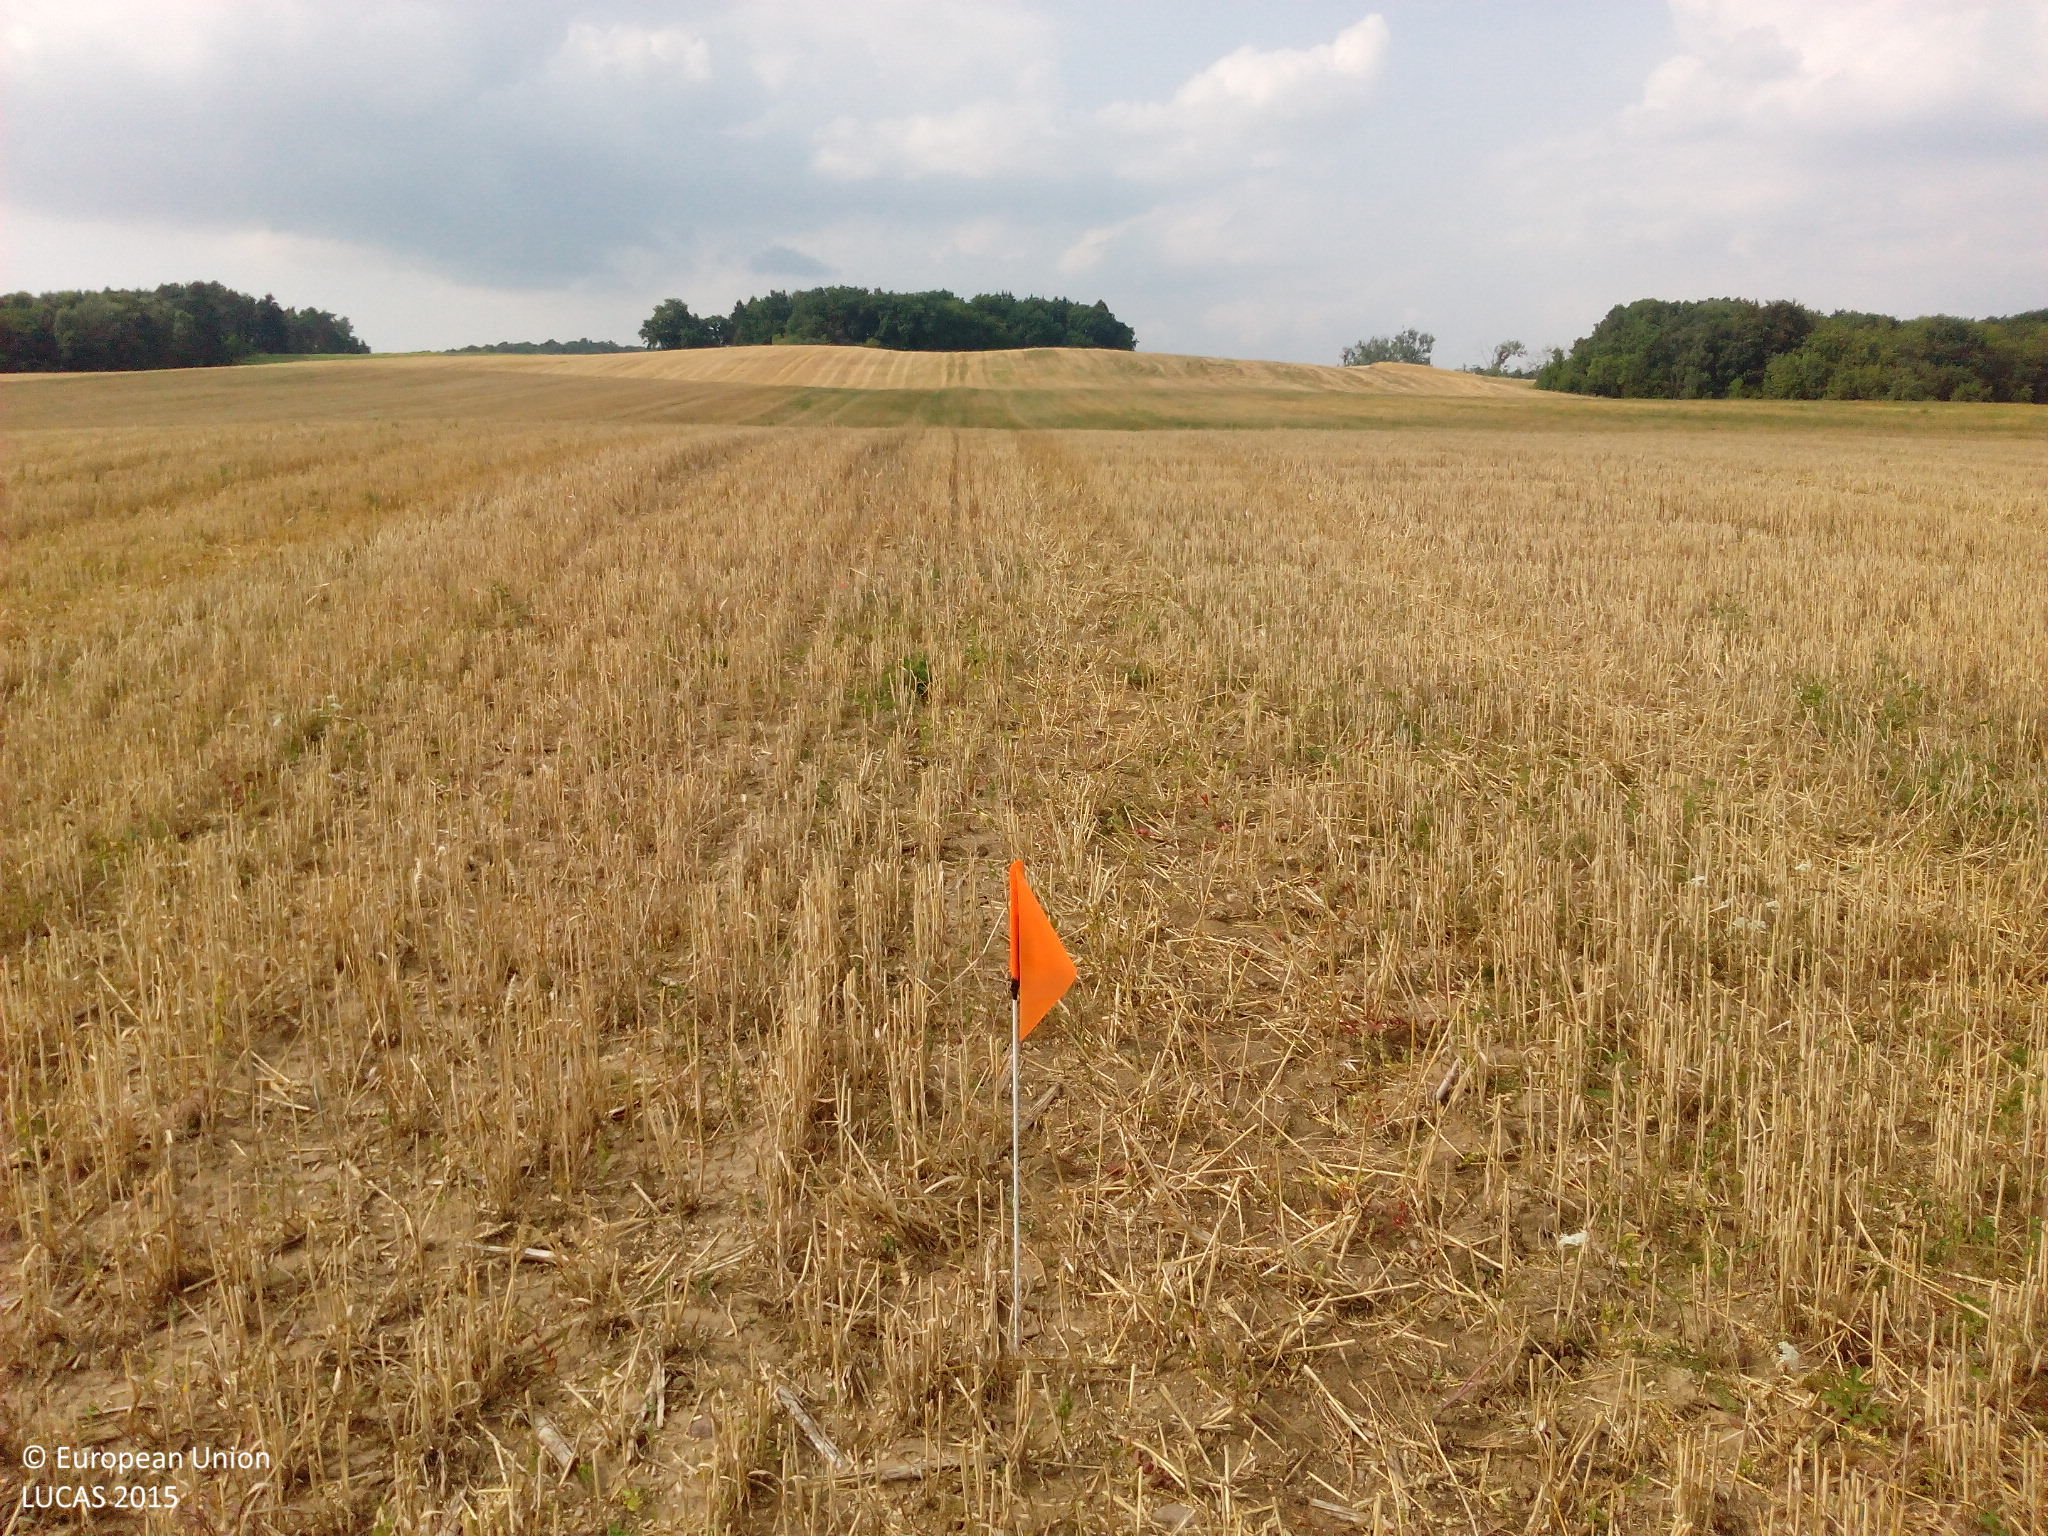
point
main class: Cropland
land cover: Common wheat
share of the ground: < 10 %
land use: Agriculture (excluding fallow land and kitchen gardens)
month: August
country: DE
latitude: 53.7332
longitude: 12.6217
